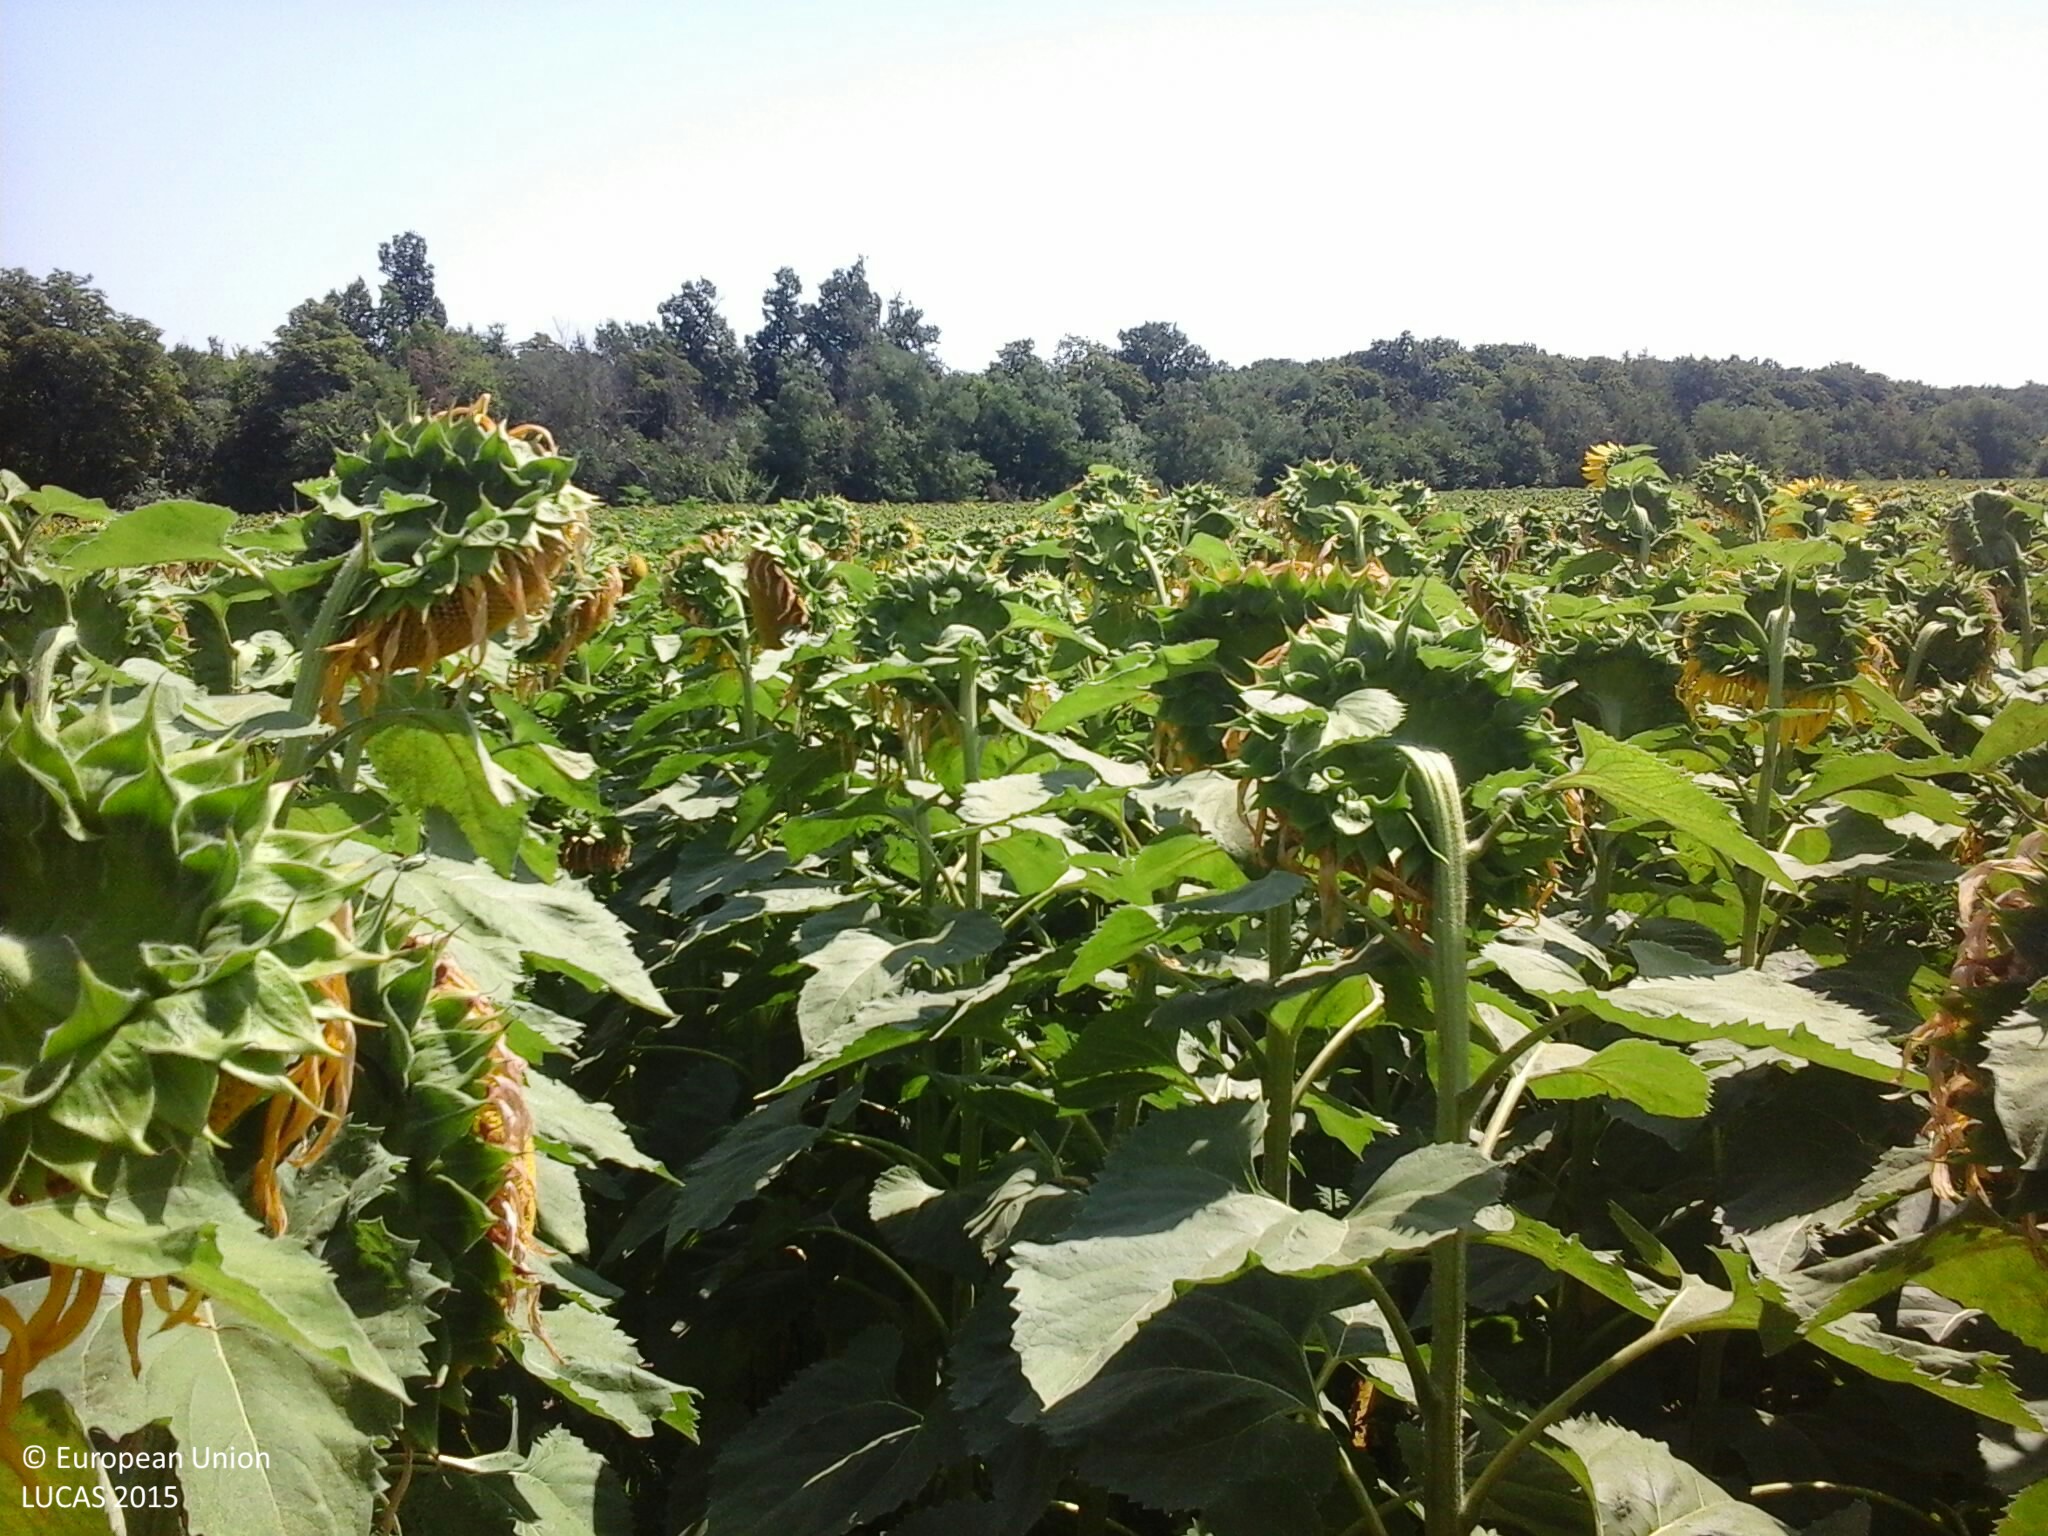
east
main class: Cropland
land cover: Sunflower
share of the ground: > 75 %
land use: Agriculture (excluding fallow land and kitchen gardens)
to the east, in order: Sunflower; Broadleaved woodland; Grass margins; Tracks; Grass margins; Broadleaved woodland
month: July
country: HU
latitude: 47.1181
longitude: 18.2486
